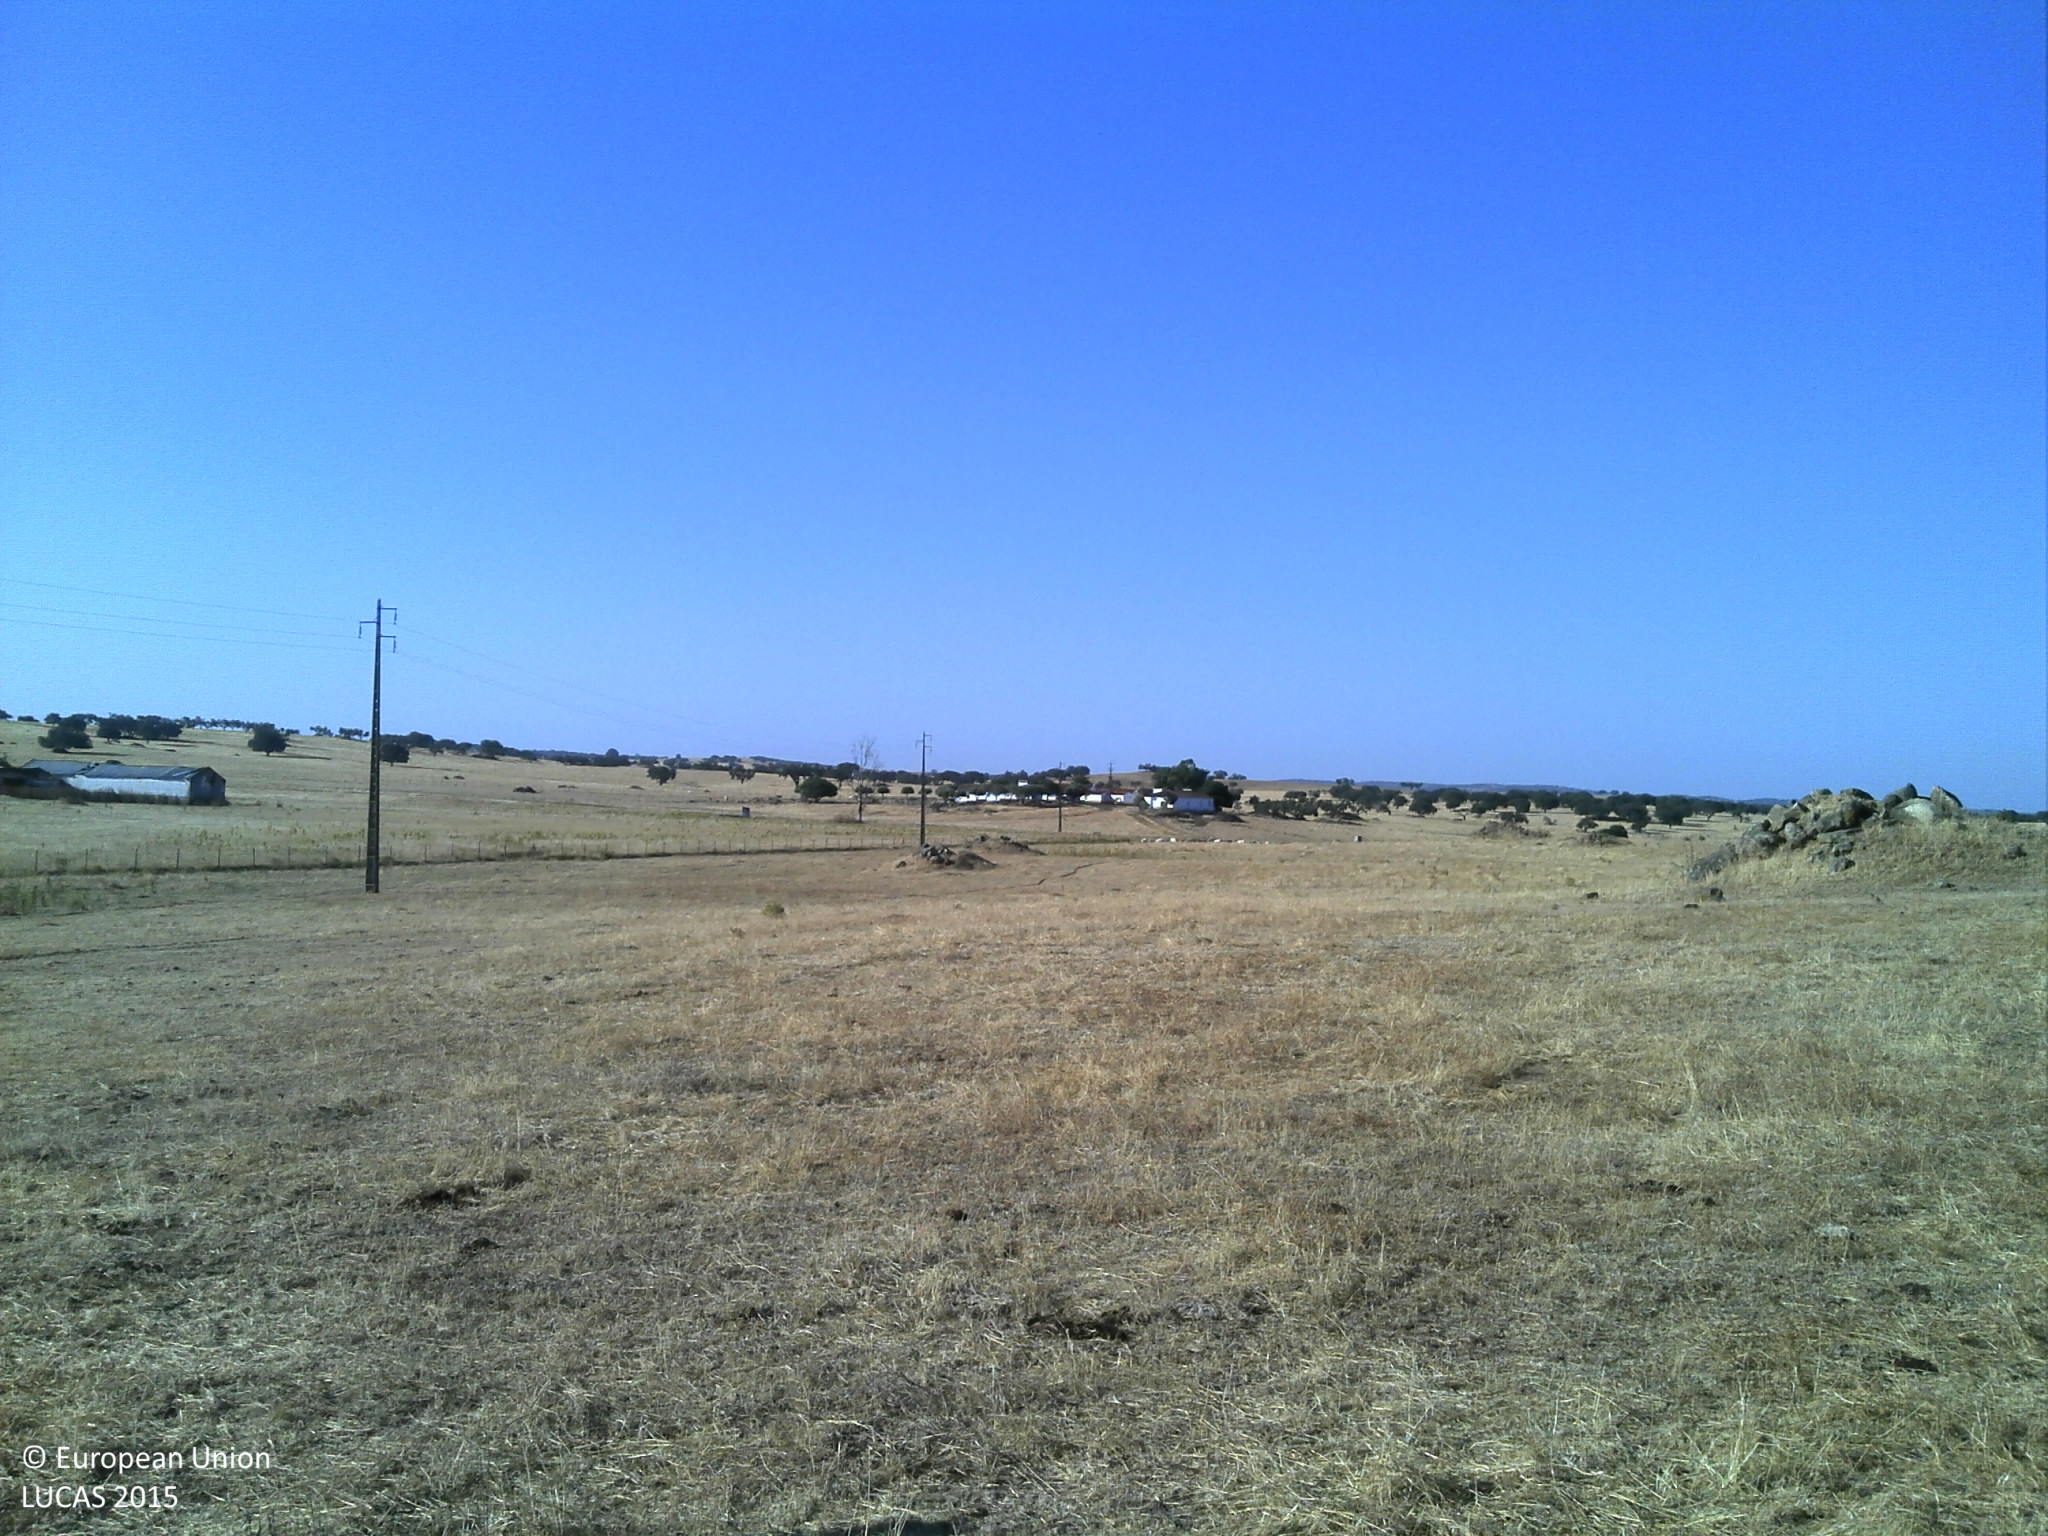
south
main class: Grassland
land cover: Grassland without tree/shrub cover
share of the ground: 10 - 25 %
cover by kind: unconsolidated bare surface 90 %, herbaceous plants 10 %
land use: Agriculture (excluding fallow land and kitchen gardens)
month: July
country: PT
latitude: 38.9922
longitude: -7.4115
